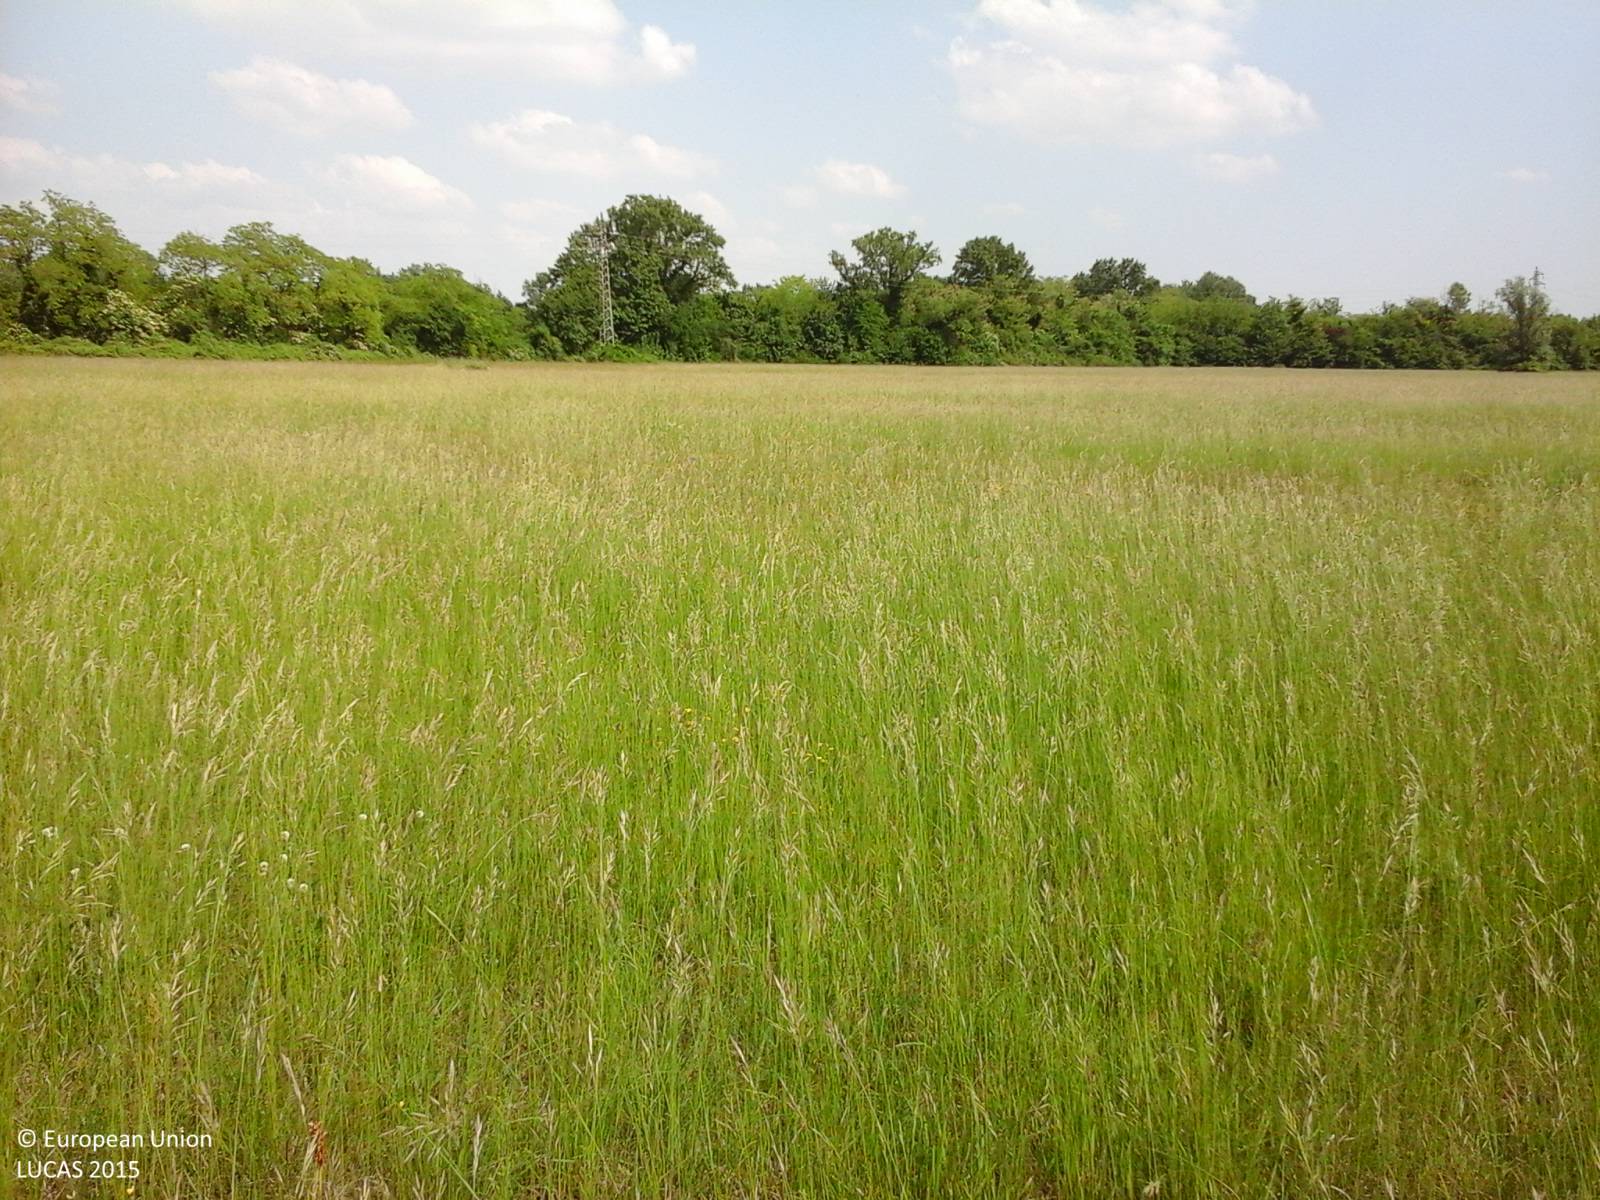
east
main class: Grassland
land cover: Grassland without tree/shrub cover
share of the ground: > 75 %
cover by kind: herbaceous plants 100 %
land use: Agriculture (excluding fallow land and kitchen gardens)
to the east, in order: Grassland without tree/shrub cover; Abandoned hedges; Ditches and canals; Electric lines; Grassland without tree/shrub cover; Abandoned hedges; Maize
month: May
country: IT
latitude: 46.0474
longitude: 13.3177
